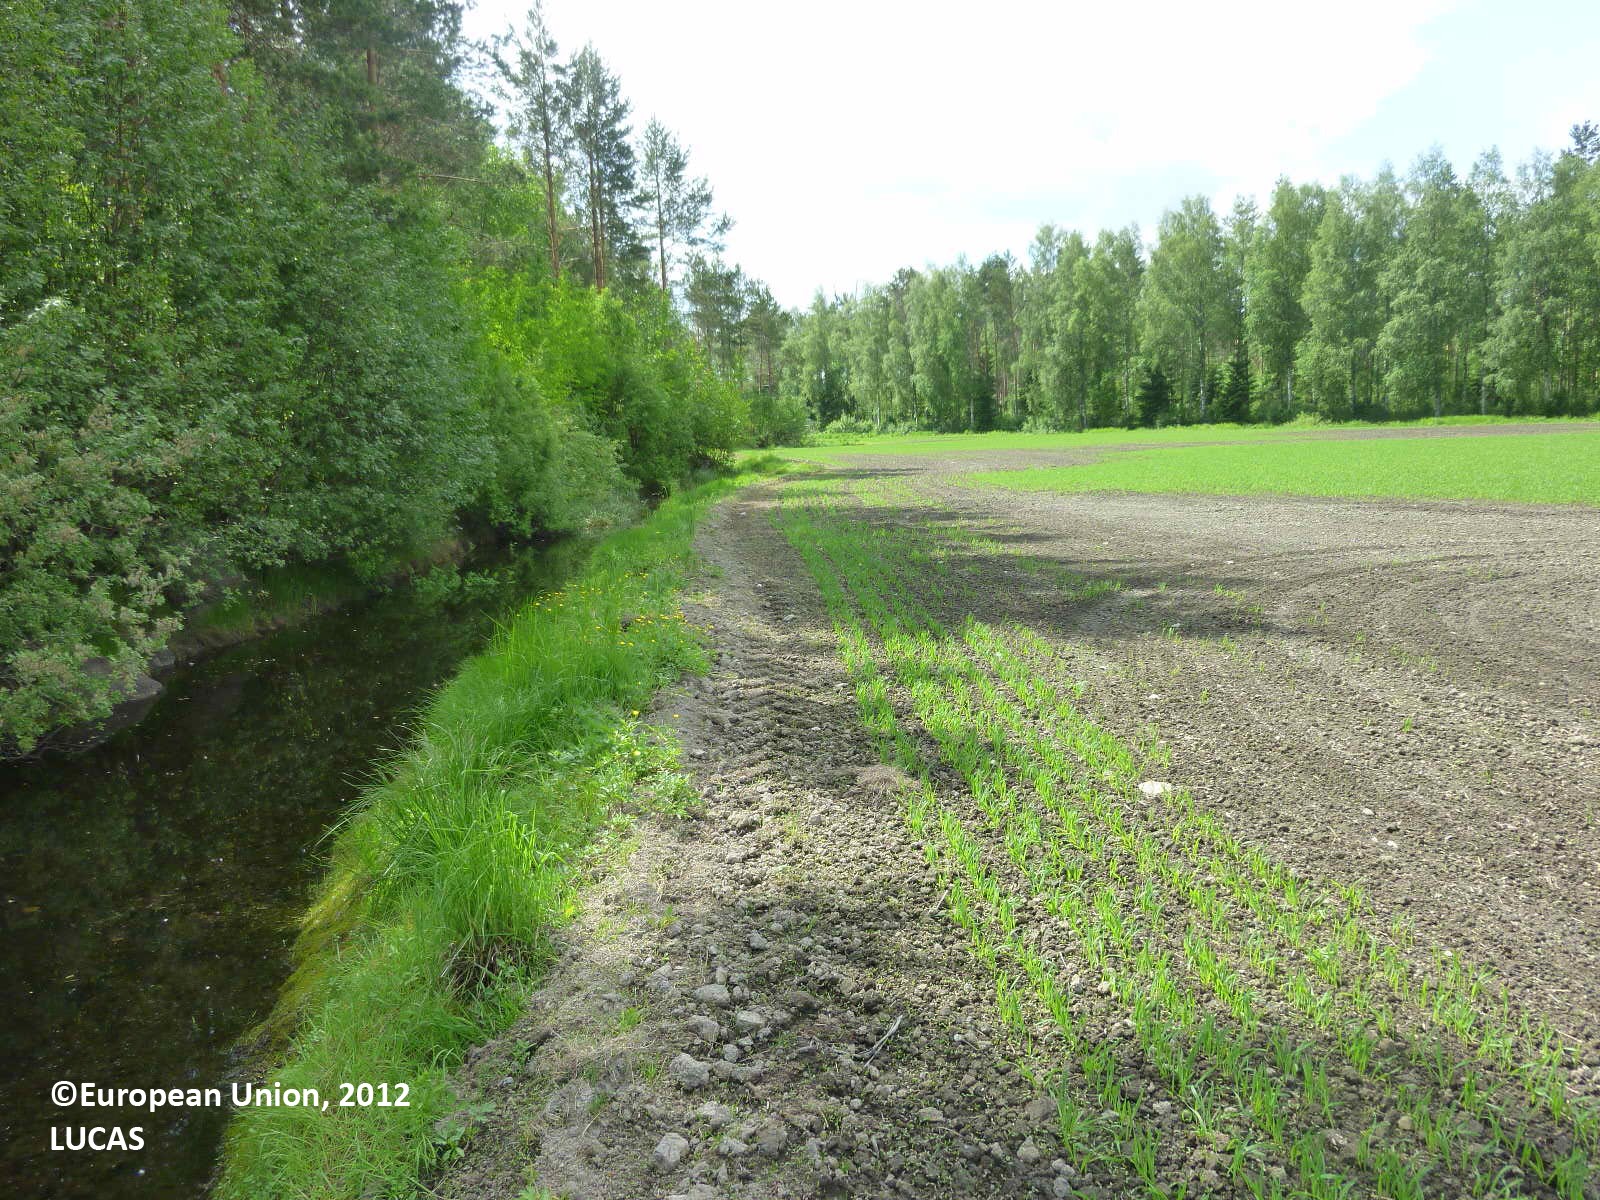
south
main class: Cropland
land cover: Oats
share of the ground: 25 - 50 %
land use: Agriculture (excluding fallow land and kitchen gardens)
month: June
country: FI
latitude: 61.3928
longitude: 22.5148
